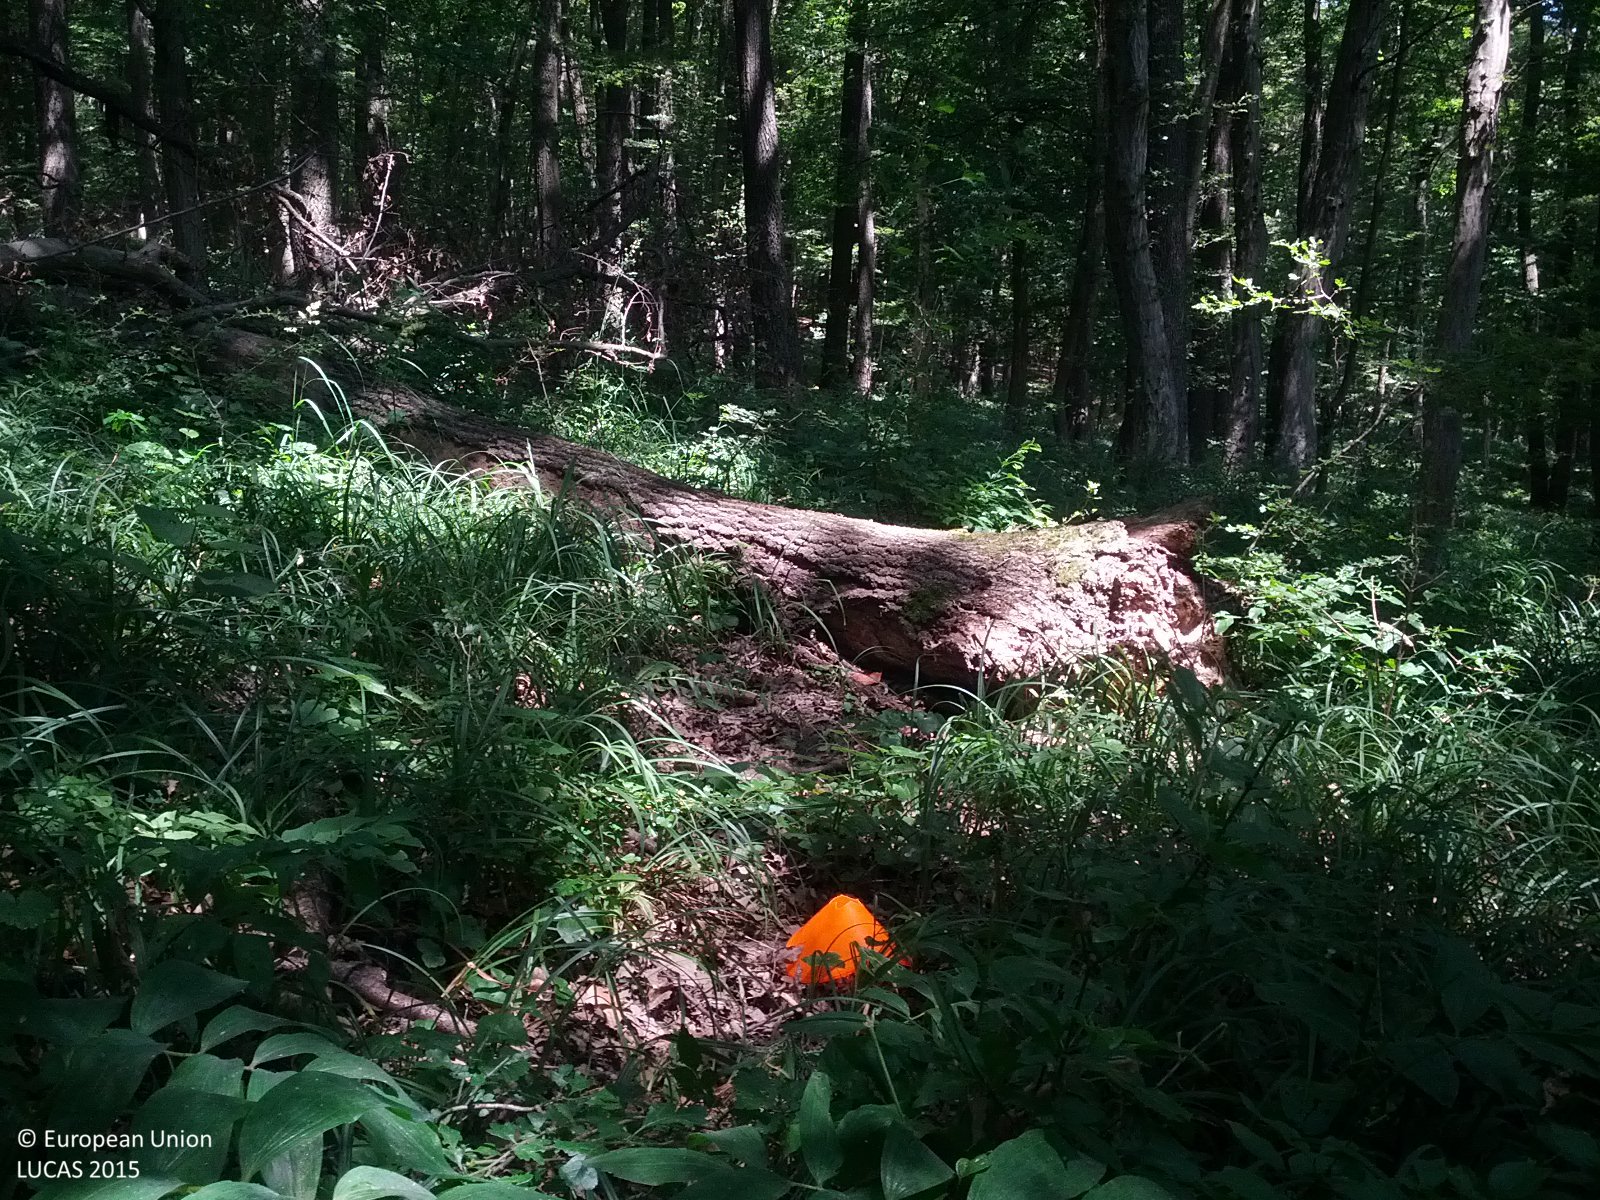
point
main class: Woodland
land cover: Broadleaved woodland
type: mesophytic deciduous forest
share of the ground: > 75 %
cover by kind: broadleaved forest trees 70 %, herbaceous plants 25 %, shrubs 5 %
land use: Forestry
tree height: > 5 m
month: June
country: AT
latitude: 48.1378
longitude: 16.2263
